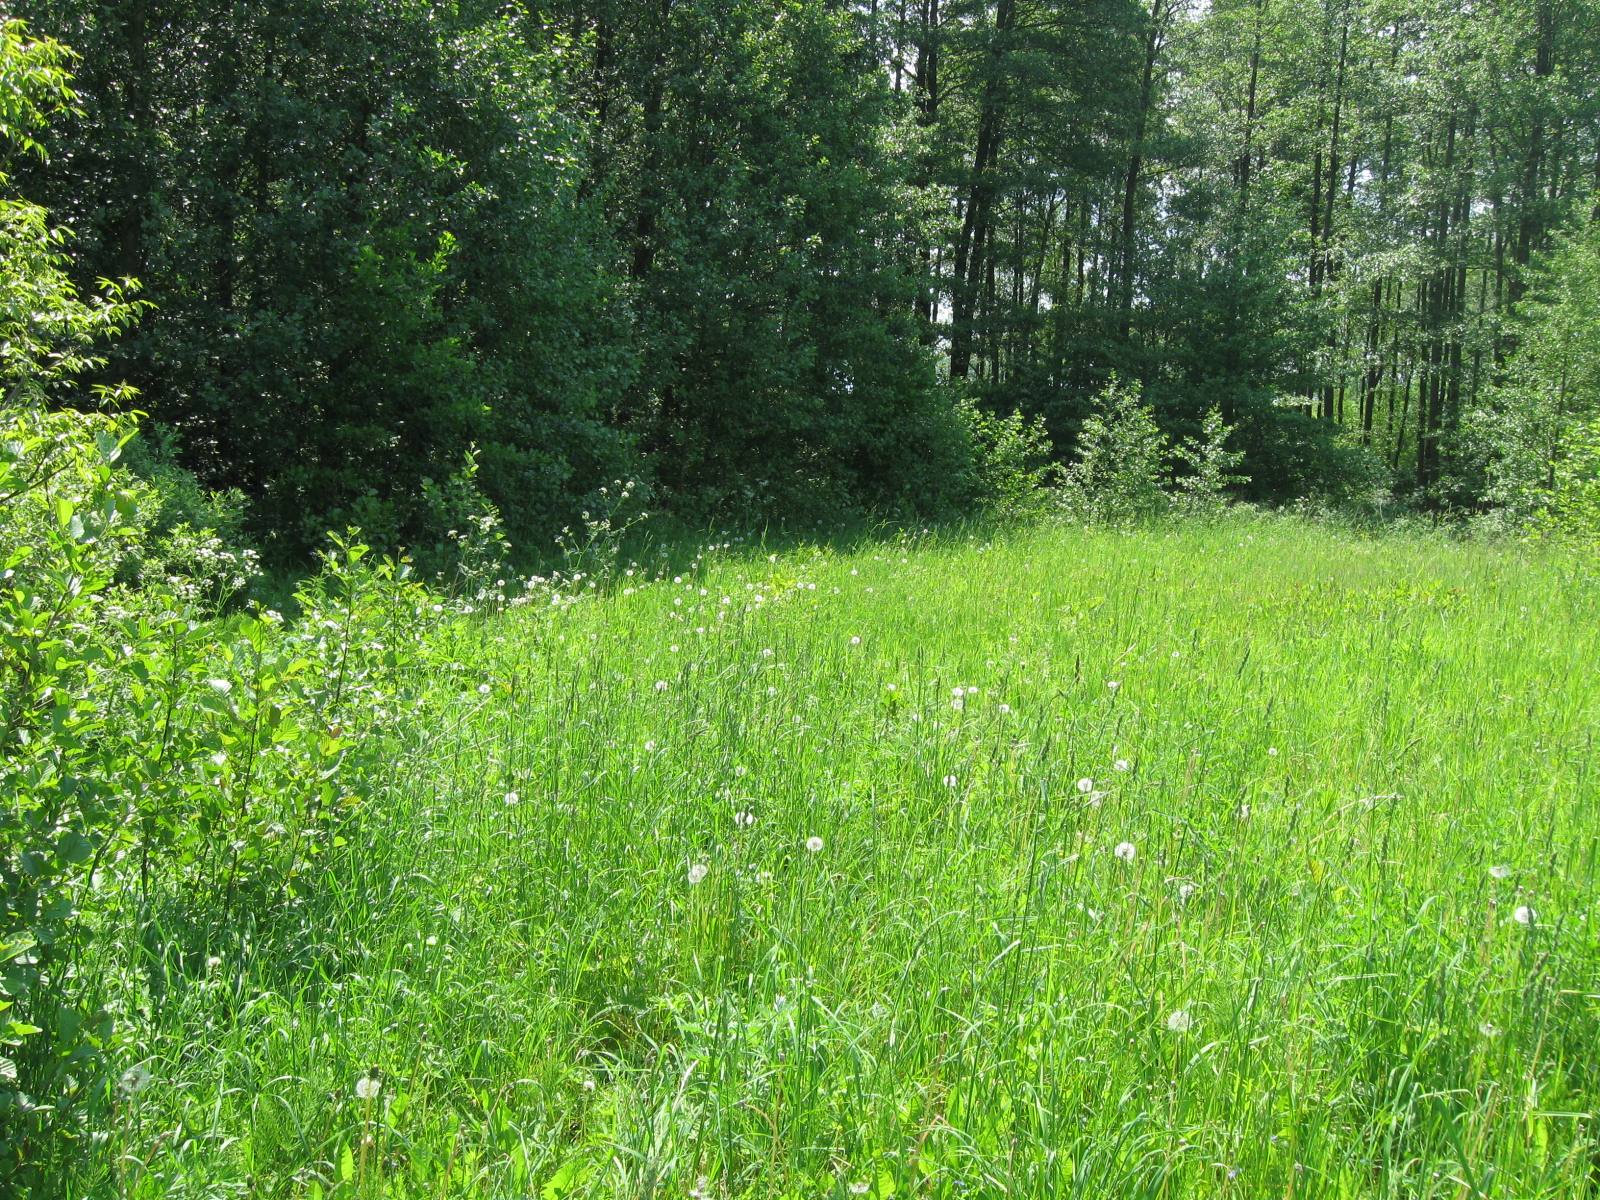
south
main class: Grassland
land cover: Grassland with sparse tree/shrub cover
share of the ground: > 75 %
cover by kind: herbaceous plants 85 %, shrubs 10 %, broadleaved forest trees 5 %
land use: Agriculture (excluding fallow land and kitchen gardens)
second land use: Residential
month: June
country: LT
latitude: 54.2086
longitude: 23.8426
